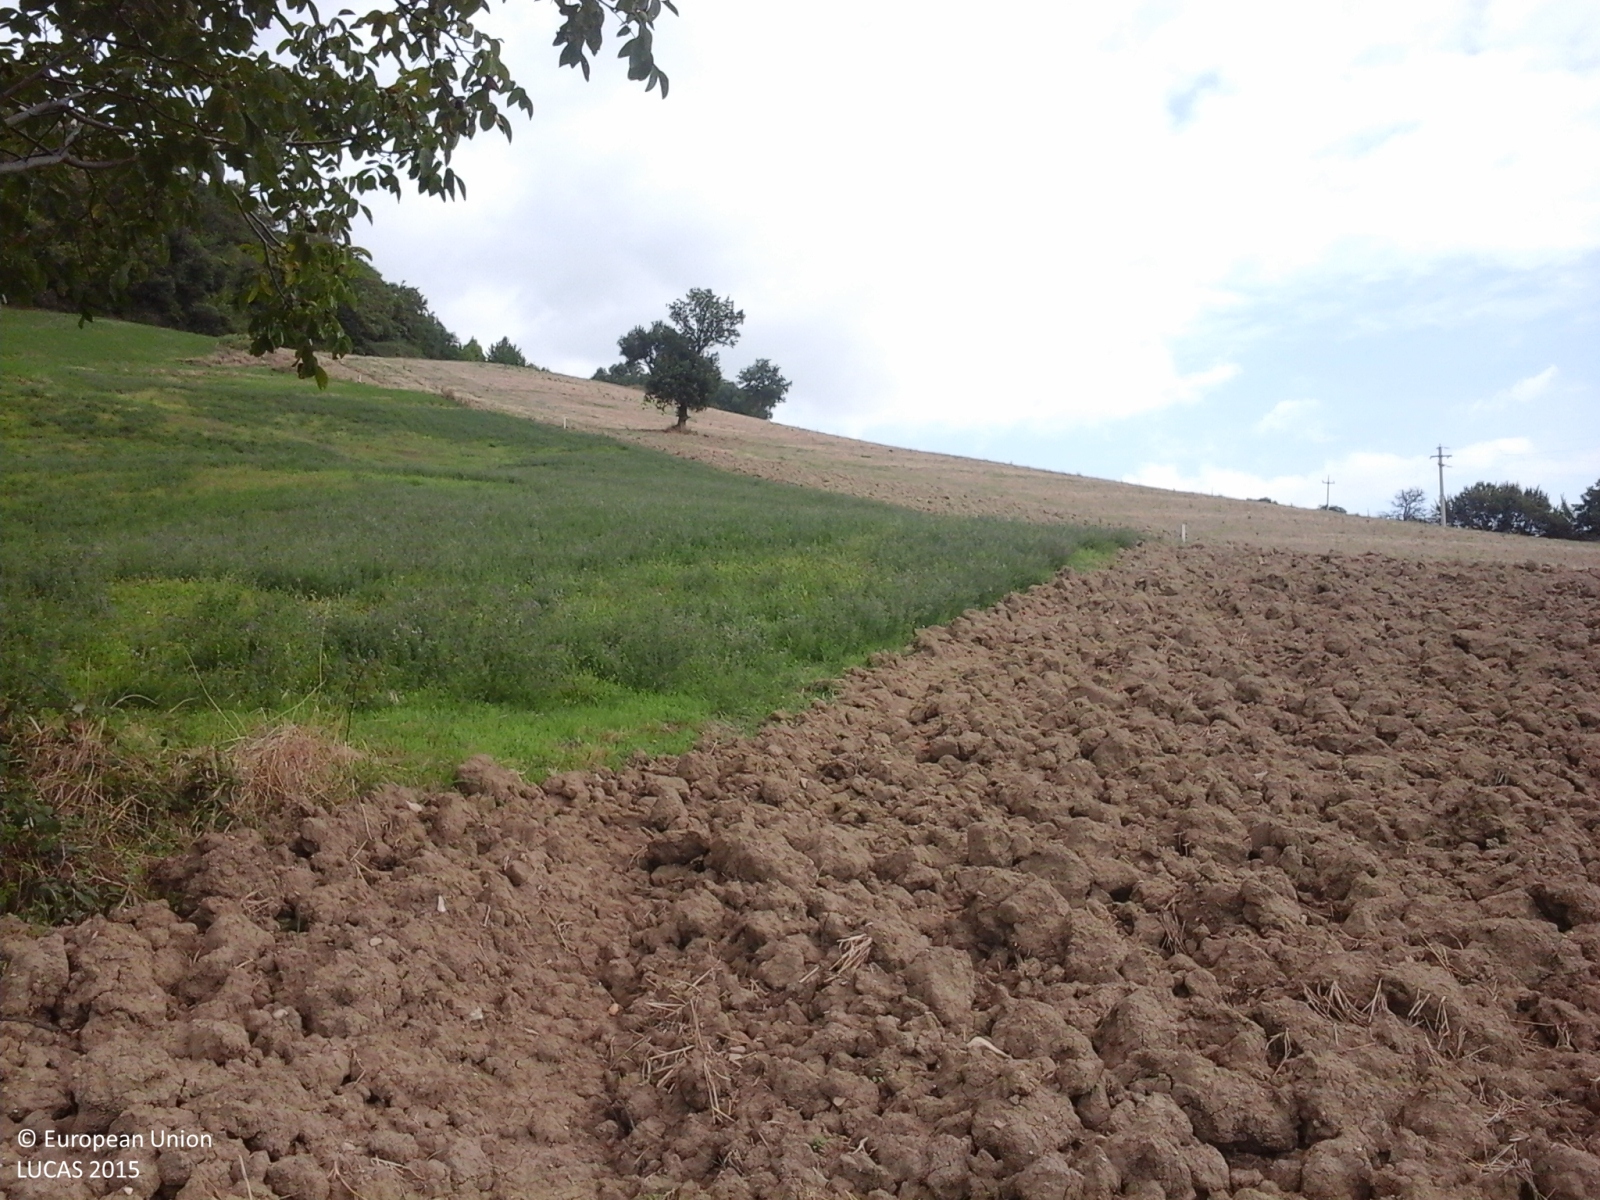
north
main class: Cropland
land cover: Durum wheat
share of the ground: < 10 %
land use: Agriculture (excluding fallow land and kitchen gardens)
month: August
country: IT
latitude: 43.3086
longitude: 13.1848
